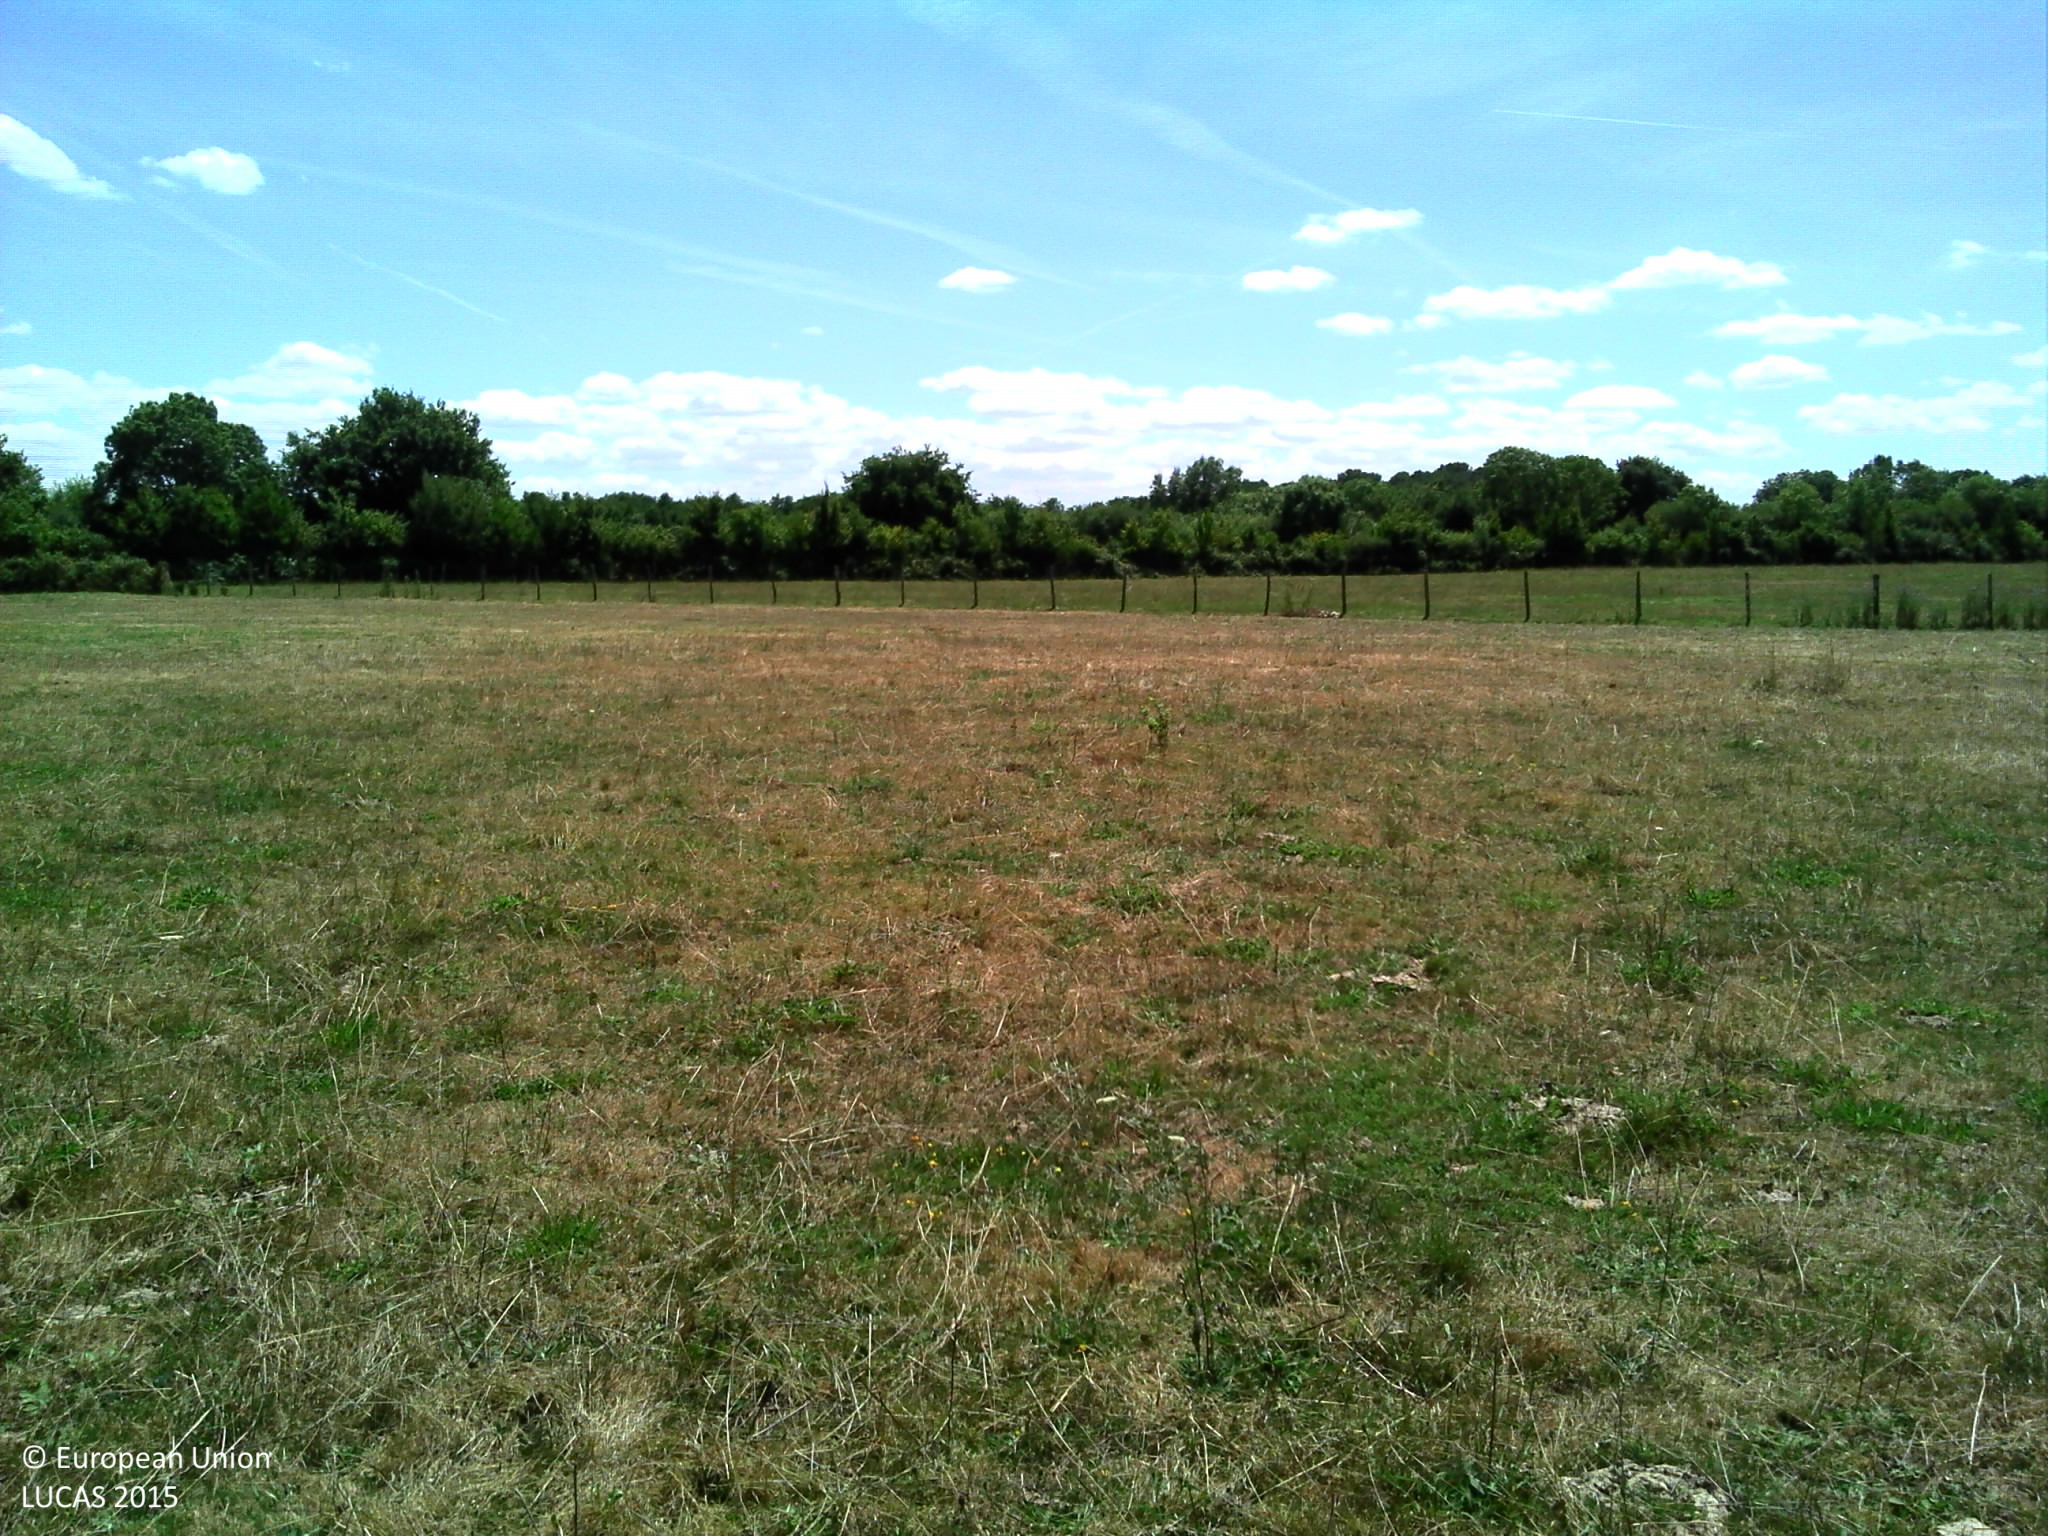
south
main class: Grassland
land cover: Grassland without tree/shrub cover
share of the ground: > 75 %
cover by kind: herbaceous plants 100 %
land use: Agriculture (excluding fallow land and kitchen gardens)
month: July
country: FR
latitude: 47.3526
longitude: -1.9494
